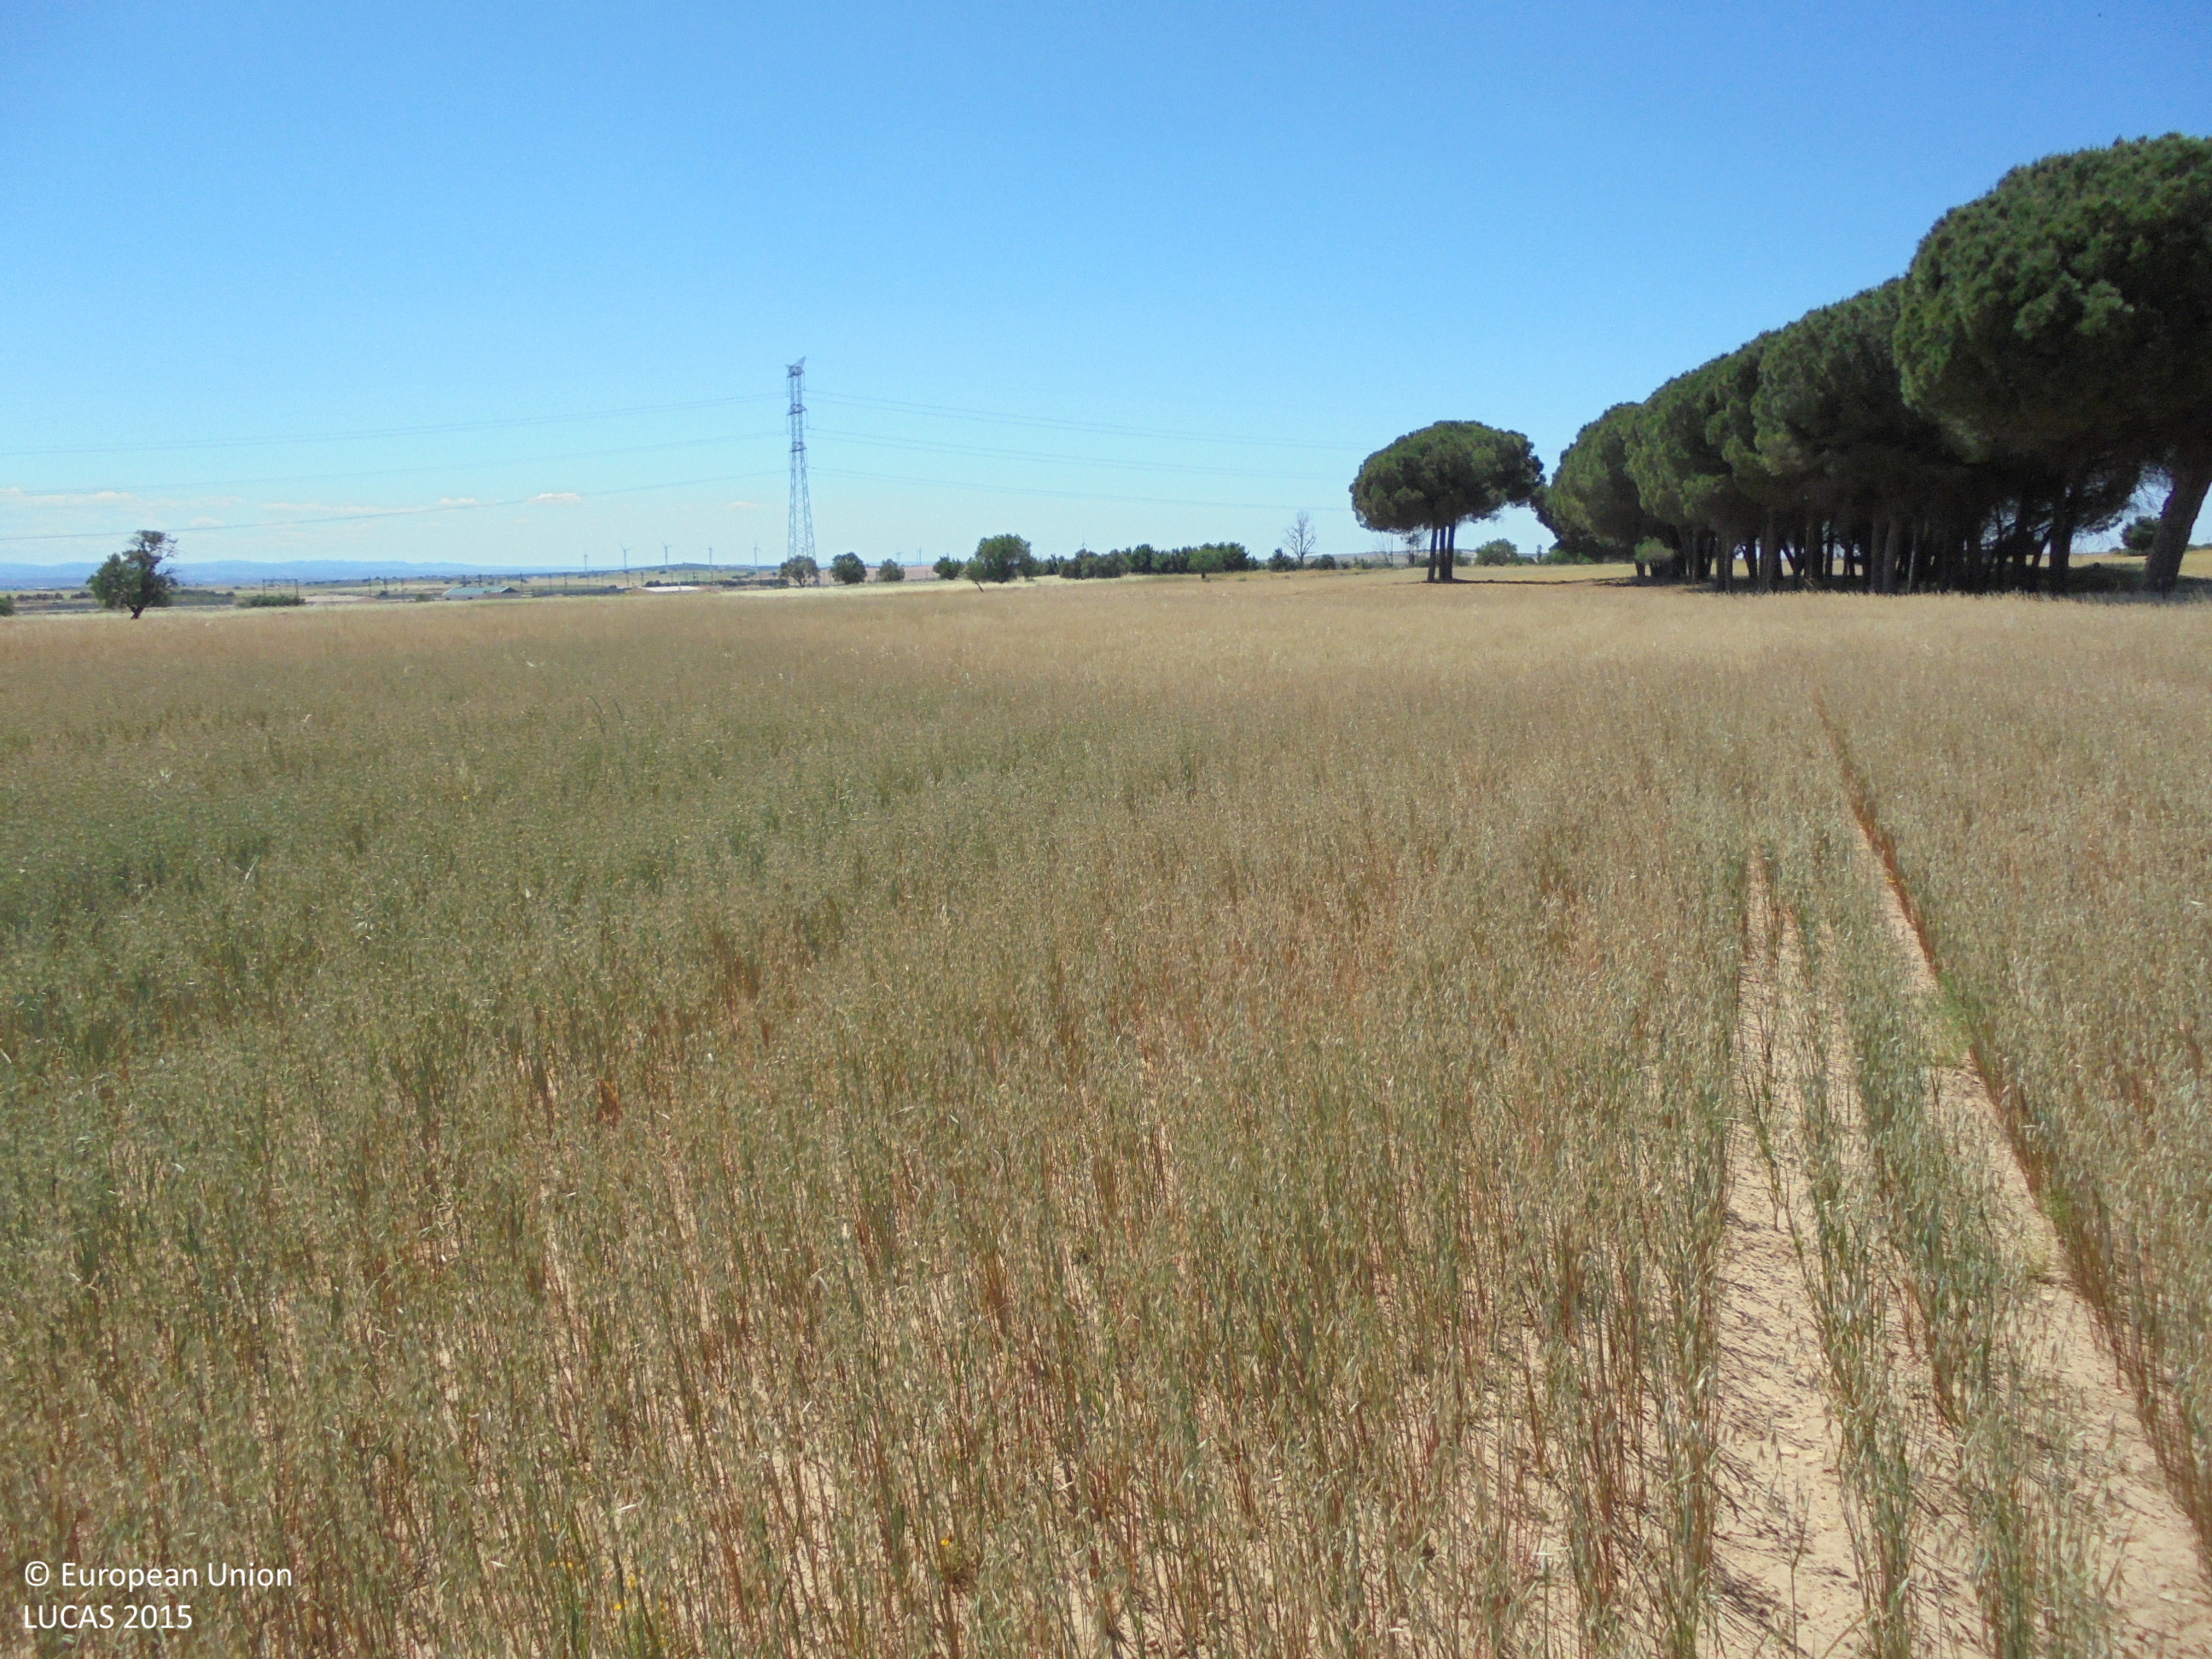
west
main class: Cropland
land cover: Oats
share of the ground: 25 - 50 %
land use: Agriculture (excluding fallow land and kitchen gardens)
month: May
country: ES
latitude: 38.9038
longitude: -1.7255
